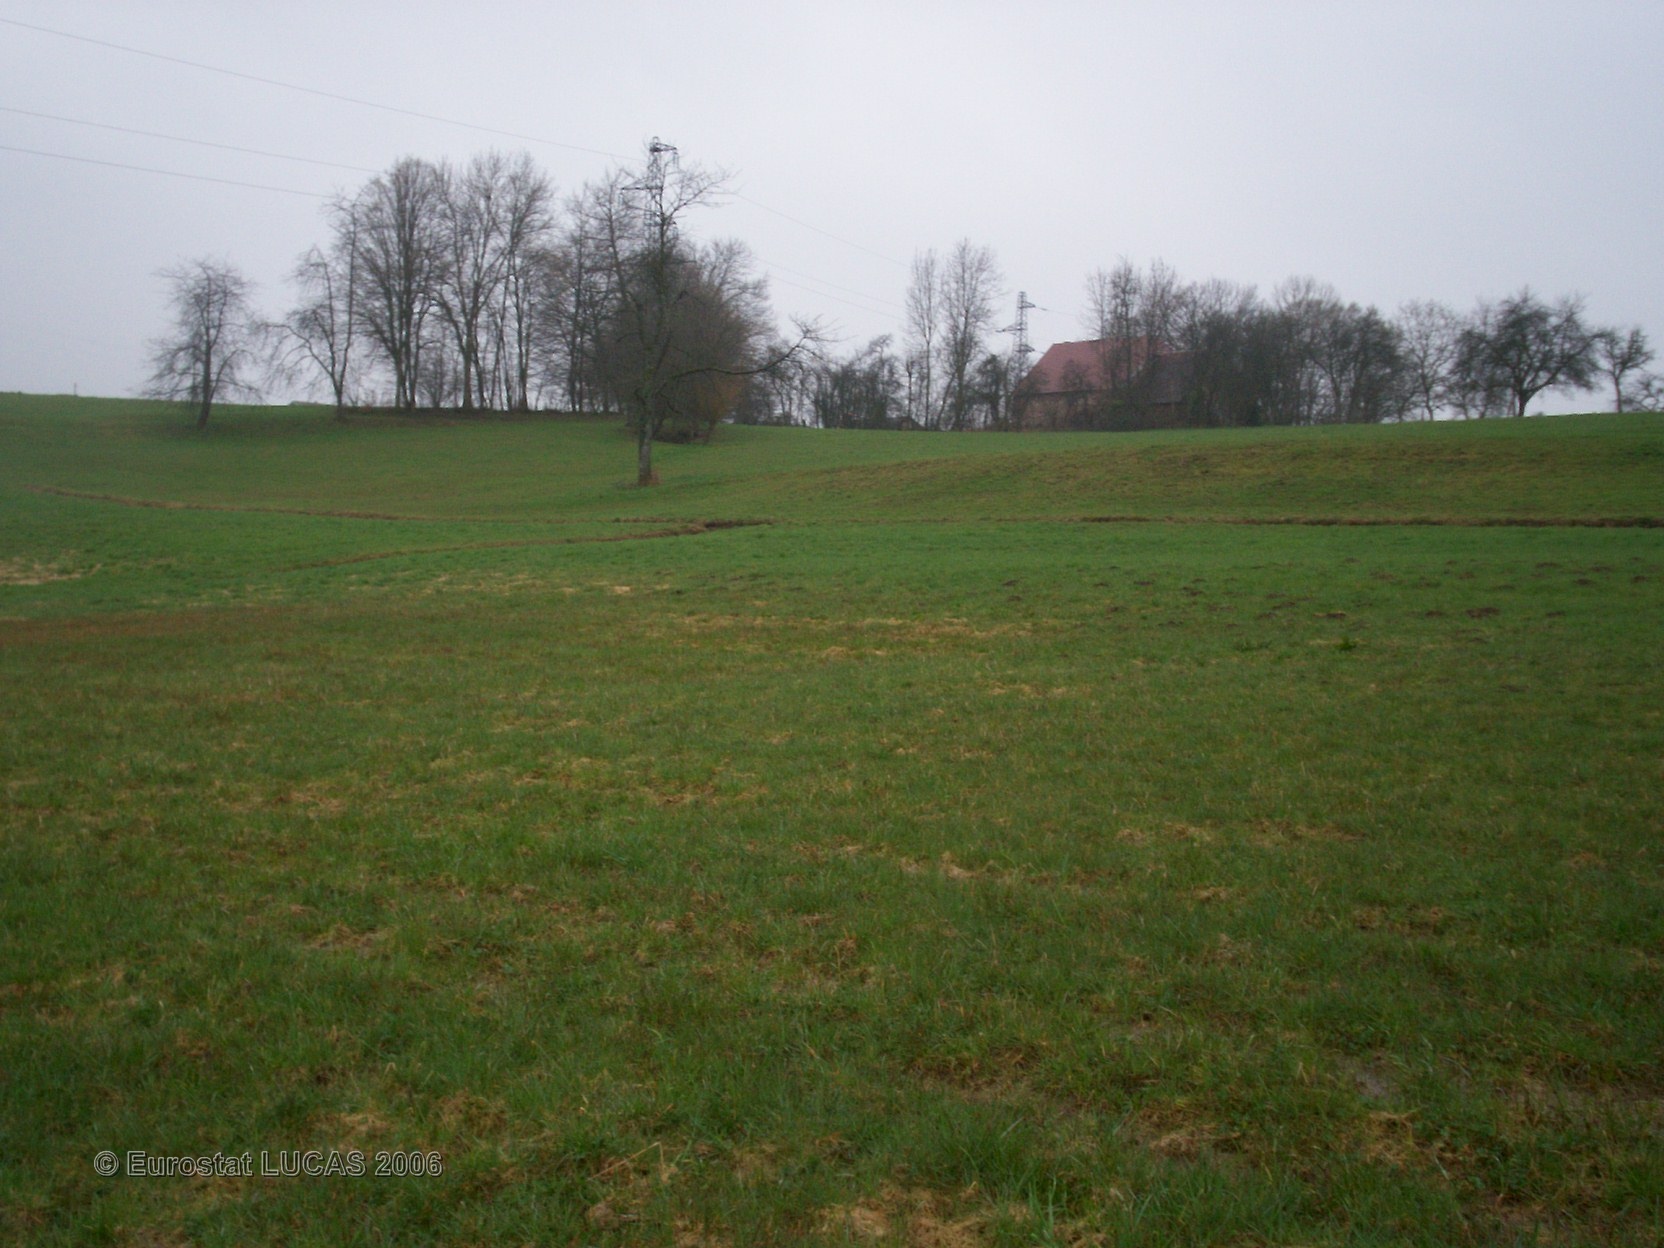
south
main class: Grassland
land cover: Grassland without tree/shrub cover
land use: Agriculture (excluding fallow land and kitchen gardens)
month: April
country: FR
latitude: 47.6661
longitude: 6.5789
